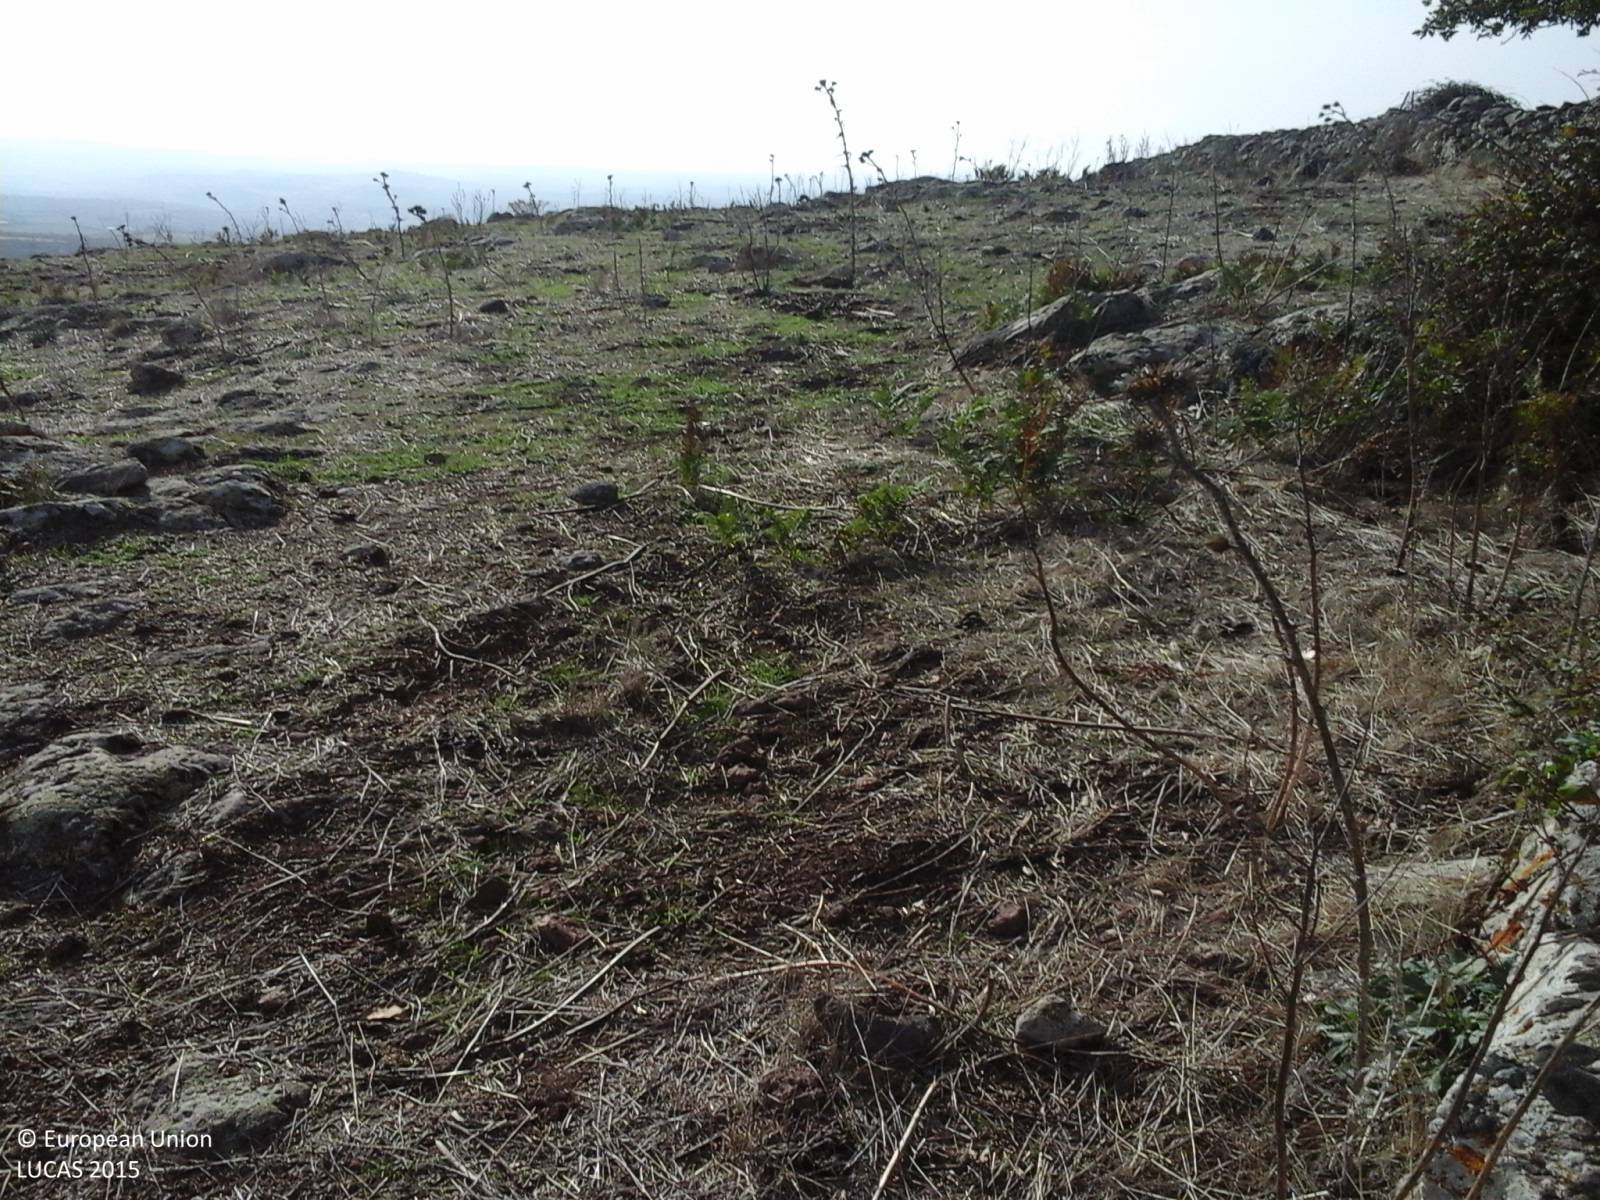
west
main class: Grassland
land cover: Grassland without tree/shrub cover
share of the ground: > 75 %
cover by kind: herbaceous plants 90 %, consolidated bare surface 10 %
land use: Agriculture (excluding fallow land and kitchen gardens)
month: October
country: IT
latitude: 40.3148
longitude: 8.8410
